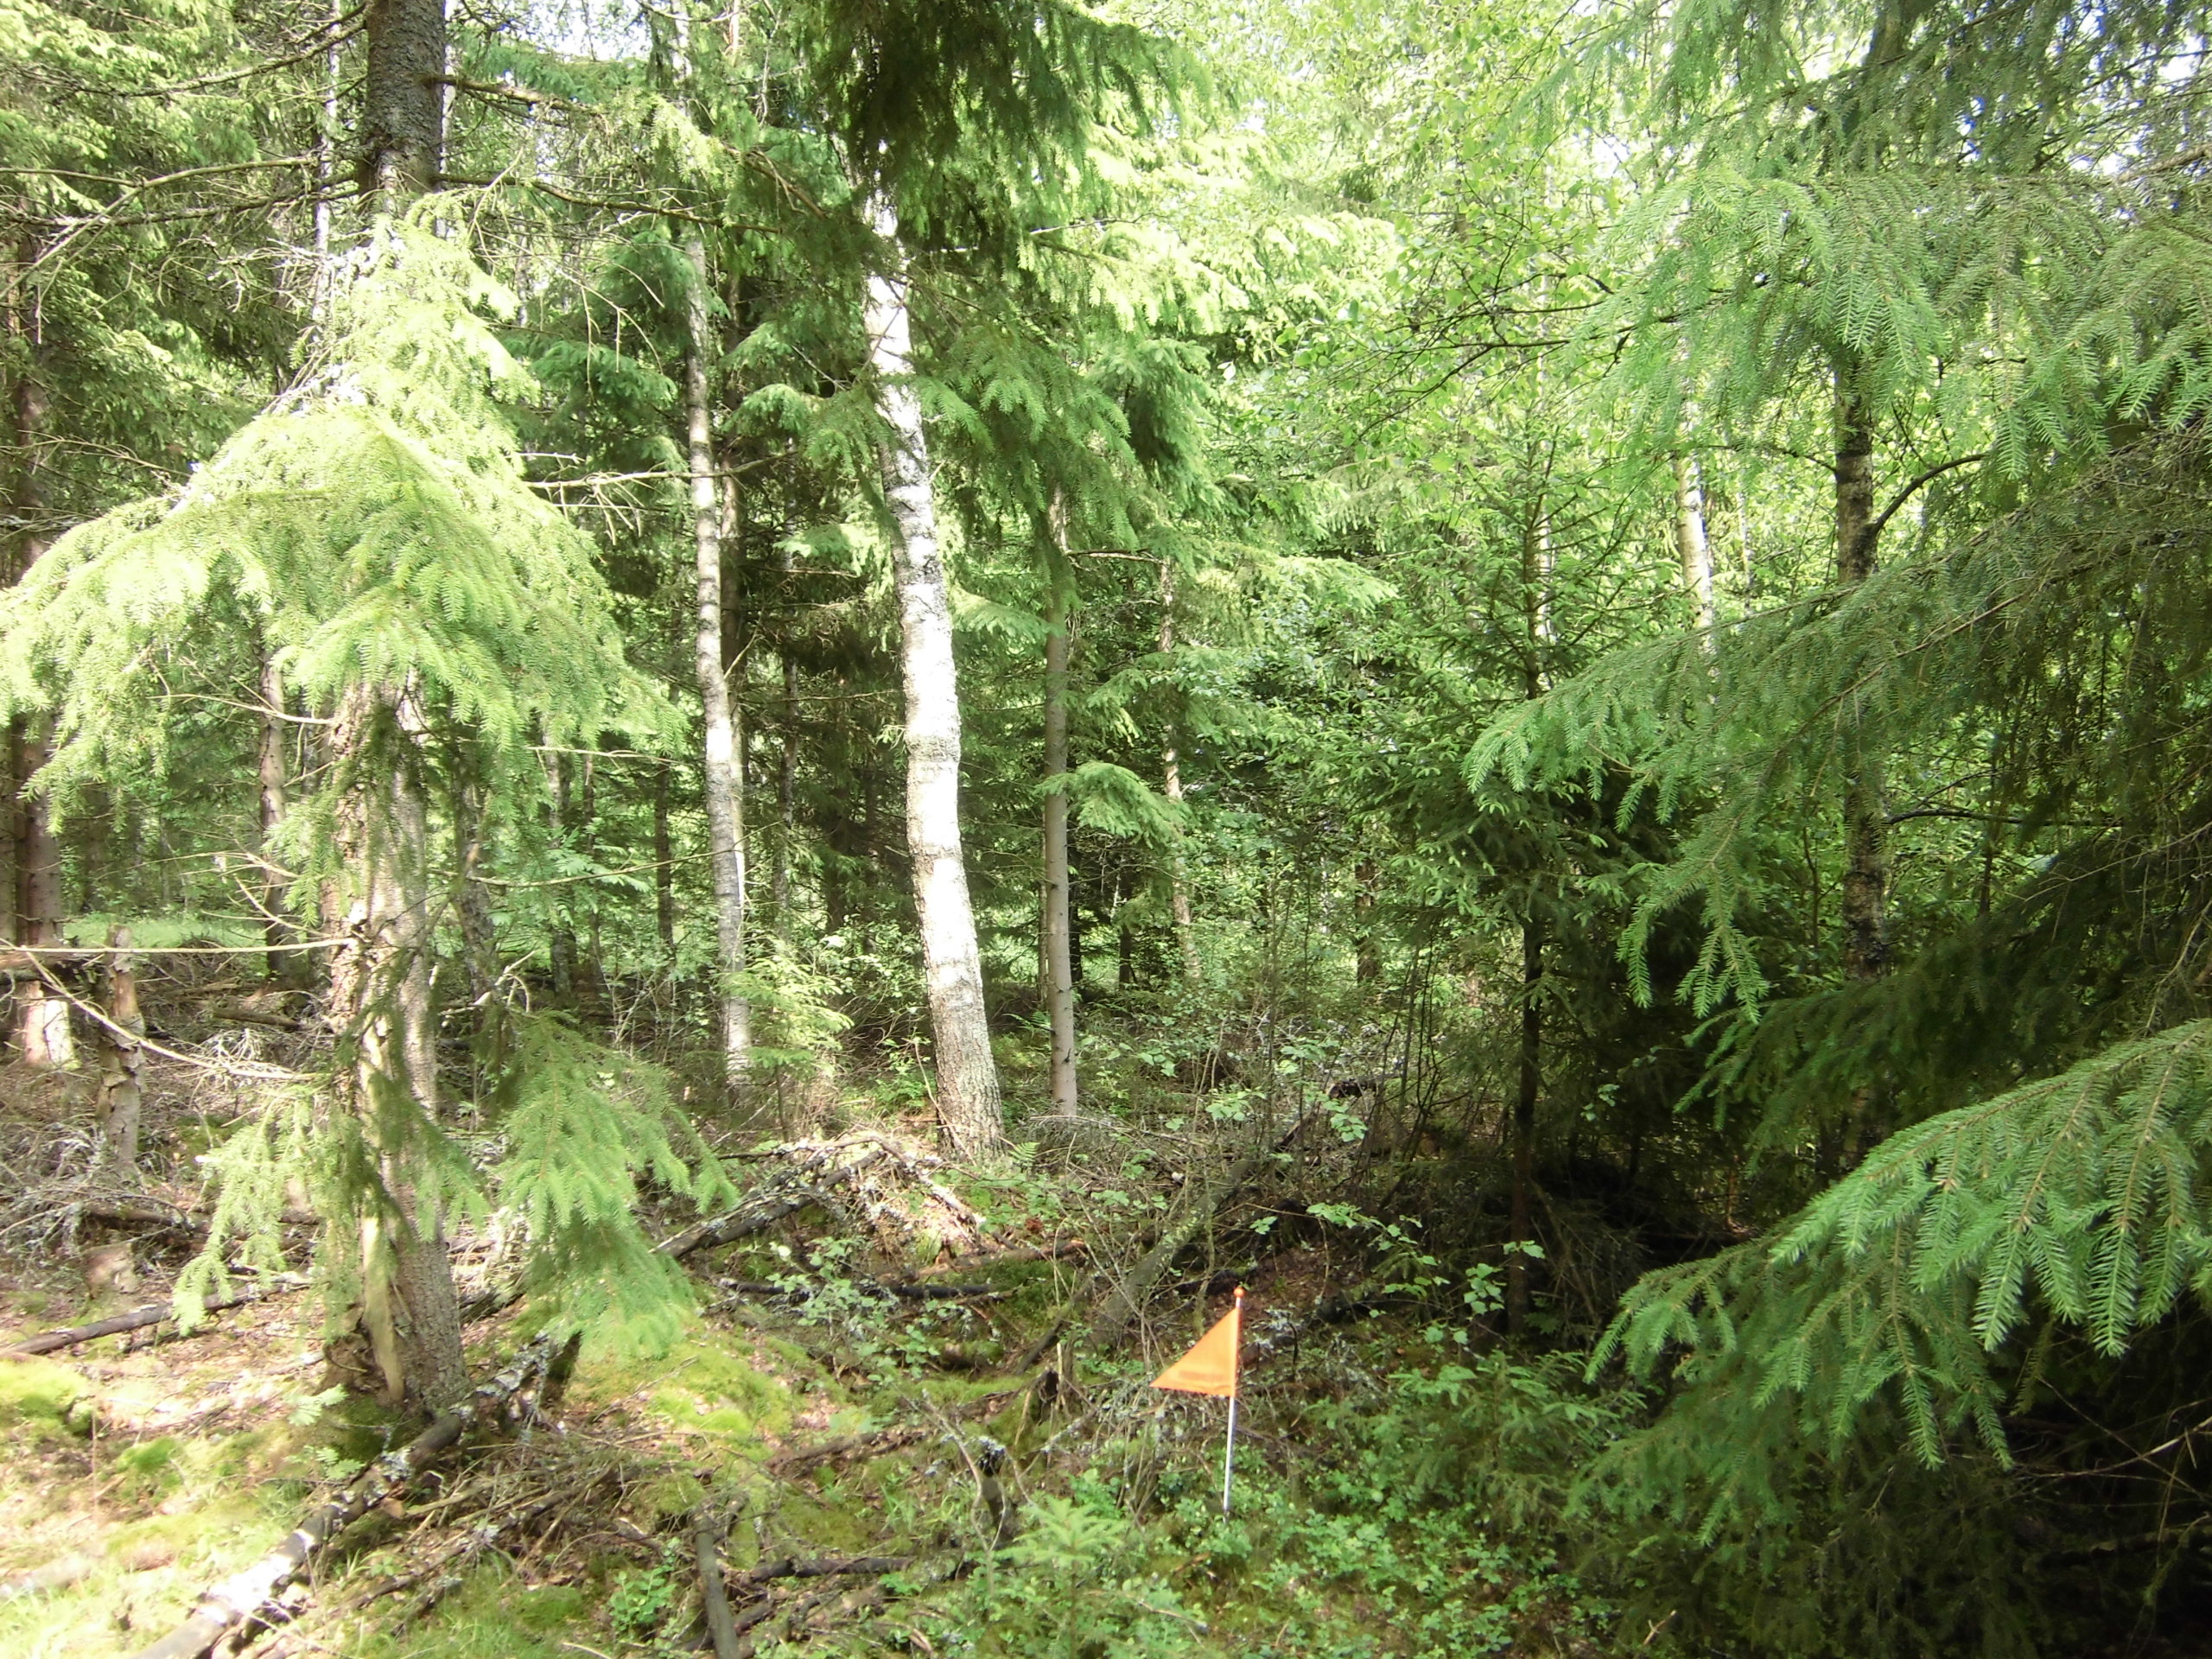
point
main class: Woodland
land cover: Spruce dominated mixed woodland
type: boreal forest
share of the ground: 50 - 75 %
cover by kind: coniferous forest trees 30 %, broadleaved forest trees 30 %, shrubs 20 %, lichens and mosses 15 %, herbaceous plants 5 %
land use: Forestry
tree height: > 5 m
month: June
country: SE
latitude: 57.0577
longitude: 14.6628
